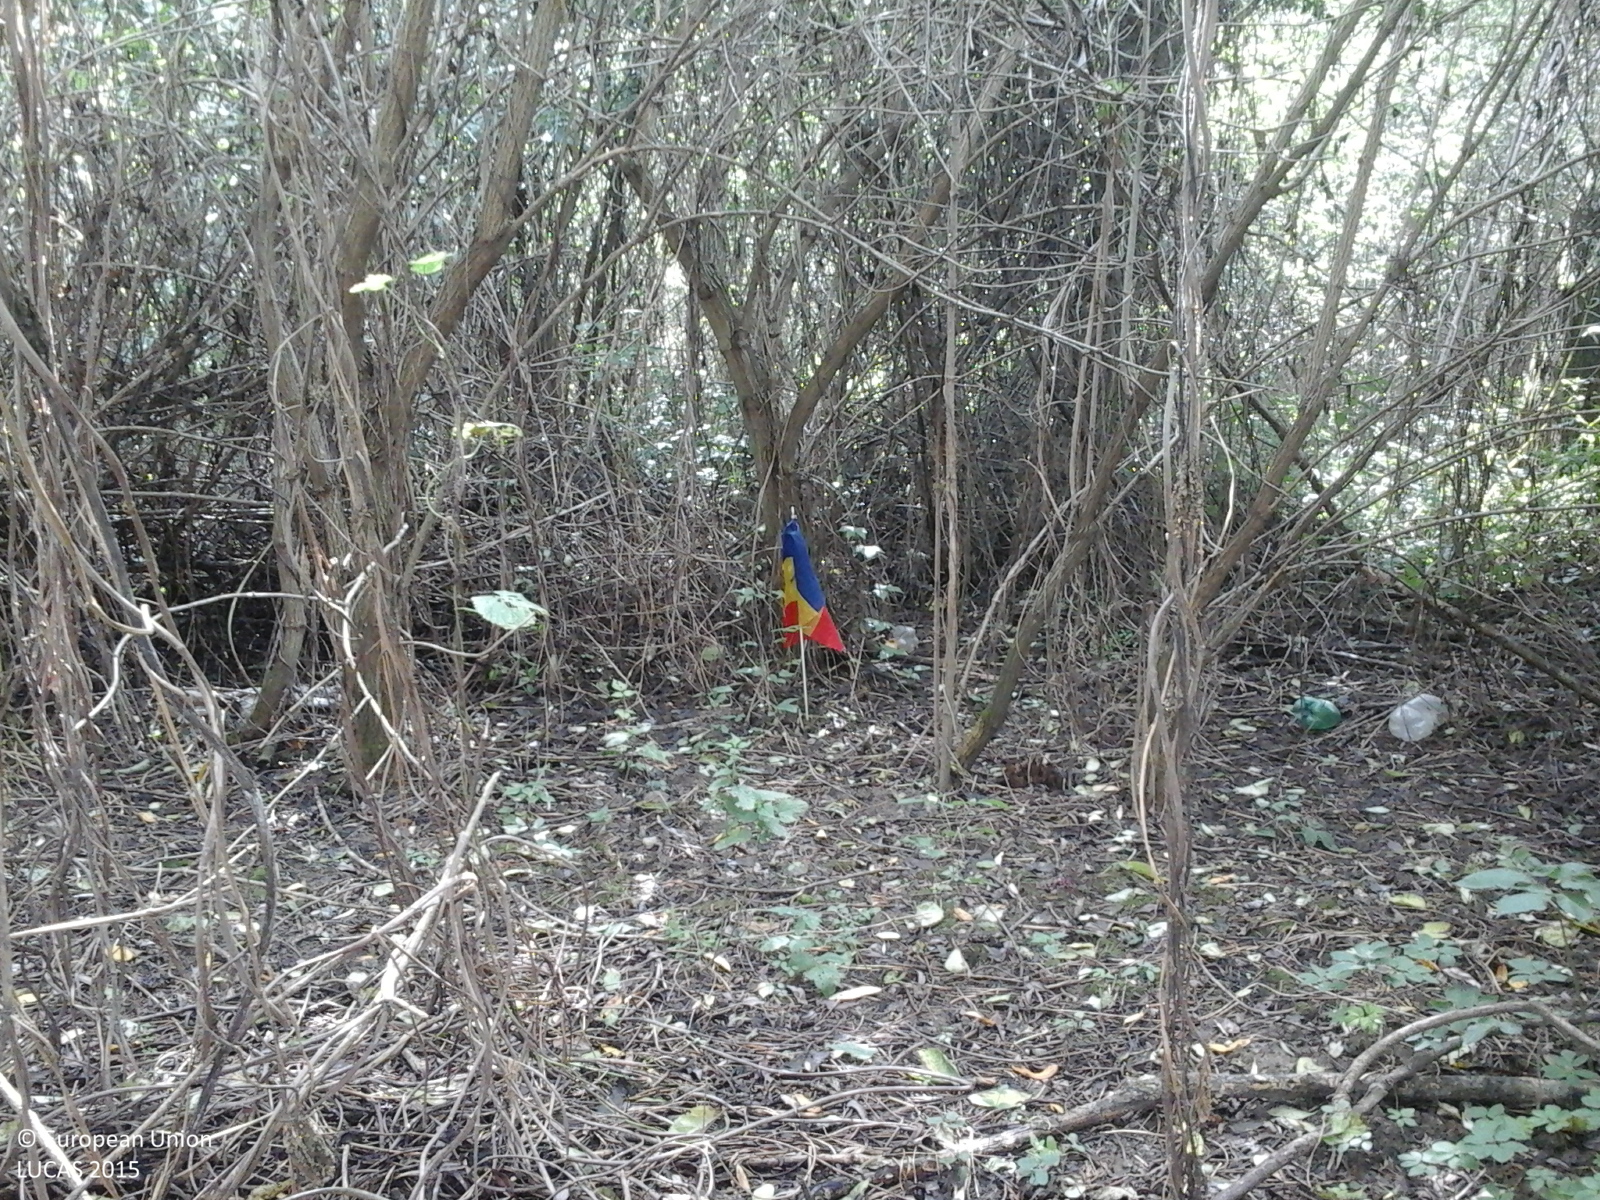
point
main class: Woodland
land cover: Broadleaved woodland
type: non-riverine alder, birch or aspen forest
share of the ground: > 75 %
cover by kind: broadleaved forest trees 100 %
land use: Forestry
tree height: > 5 m
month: September
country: RO
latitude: 47.3364
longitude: 23.4788
